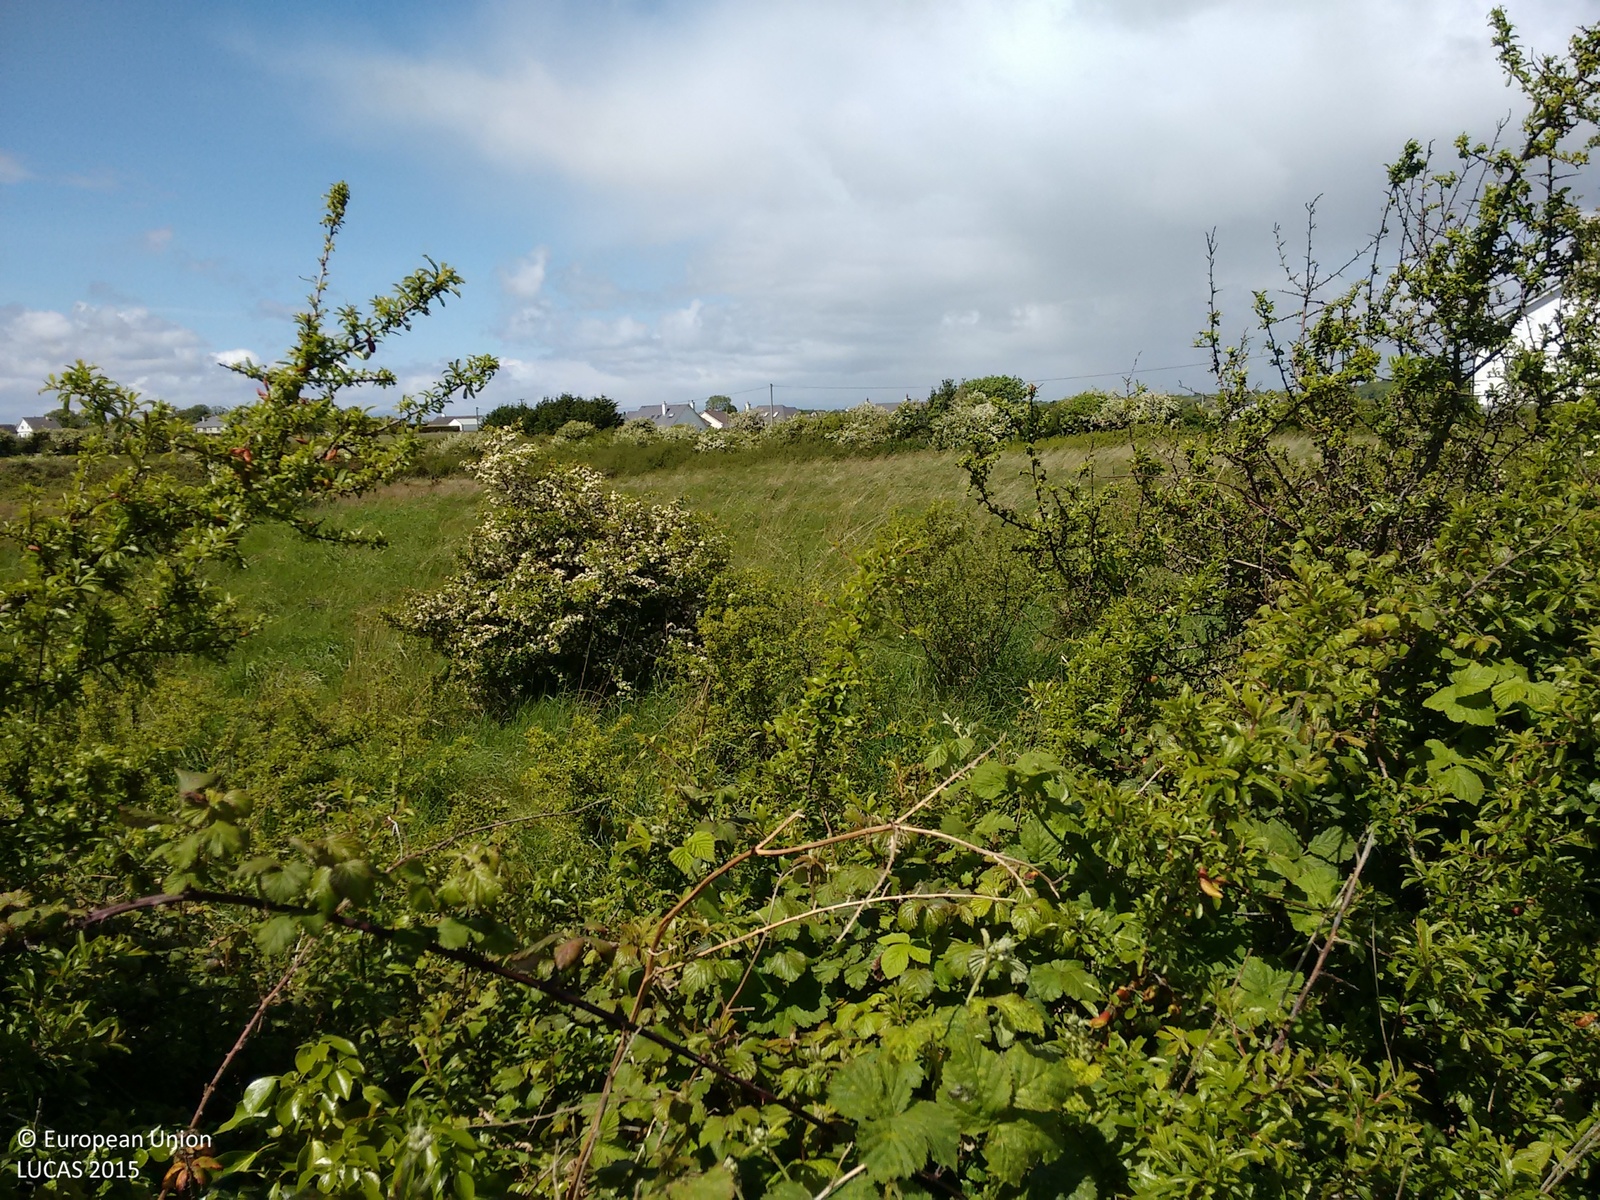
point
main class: Grassland
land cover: Grassland without tree/shrub cover
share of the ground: > 75 %
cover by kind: herbaceous plants 95 %, shrubs 5 %
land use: Agriculture (excluding fallow land and kitchen gardens)
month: May
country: IE
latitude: 53.4076
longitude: -9.0322
